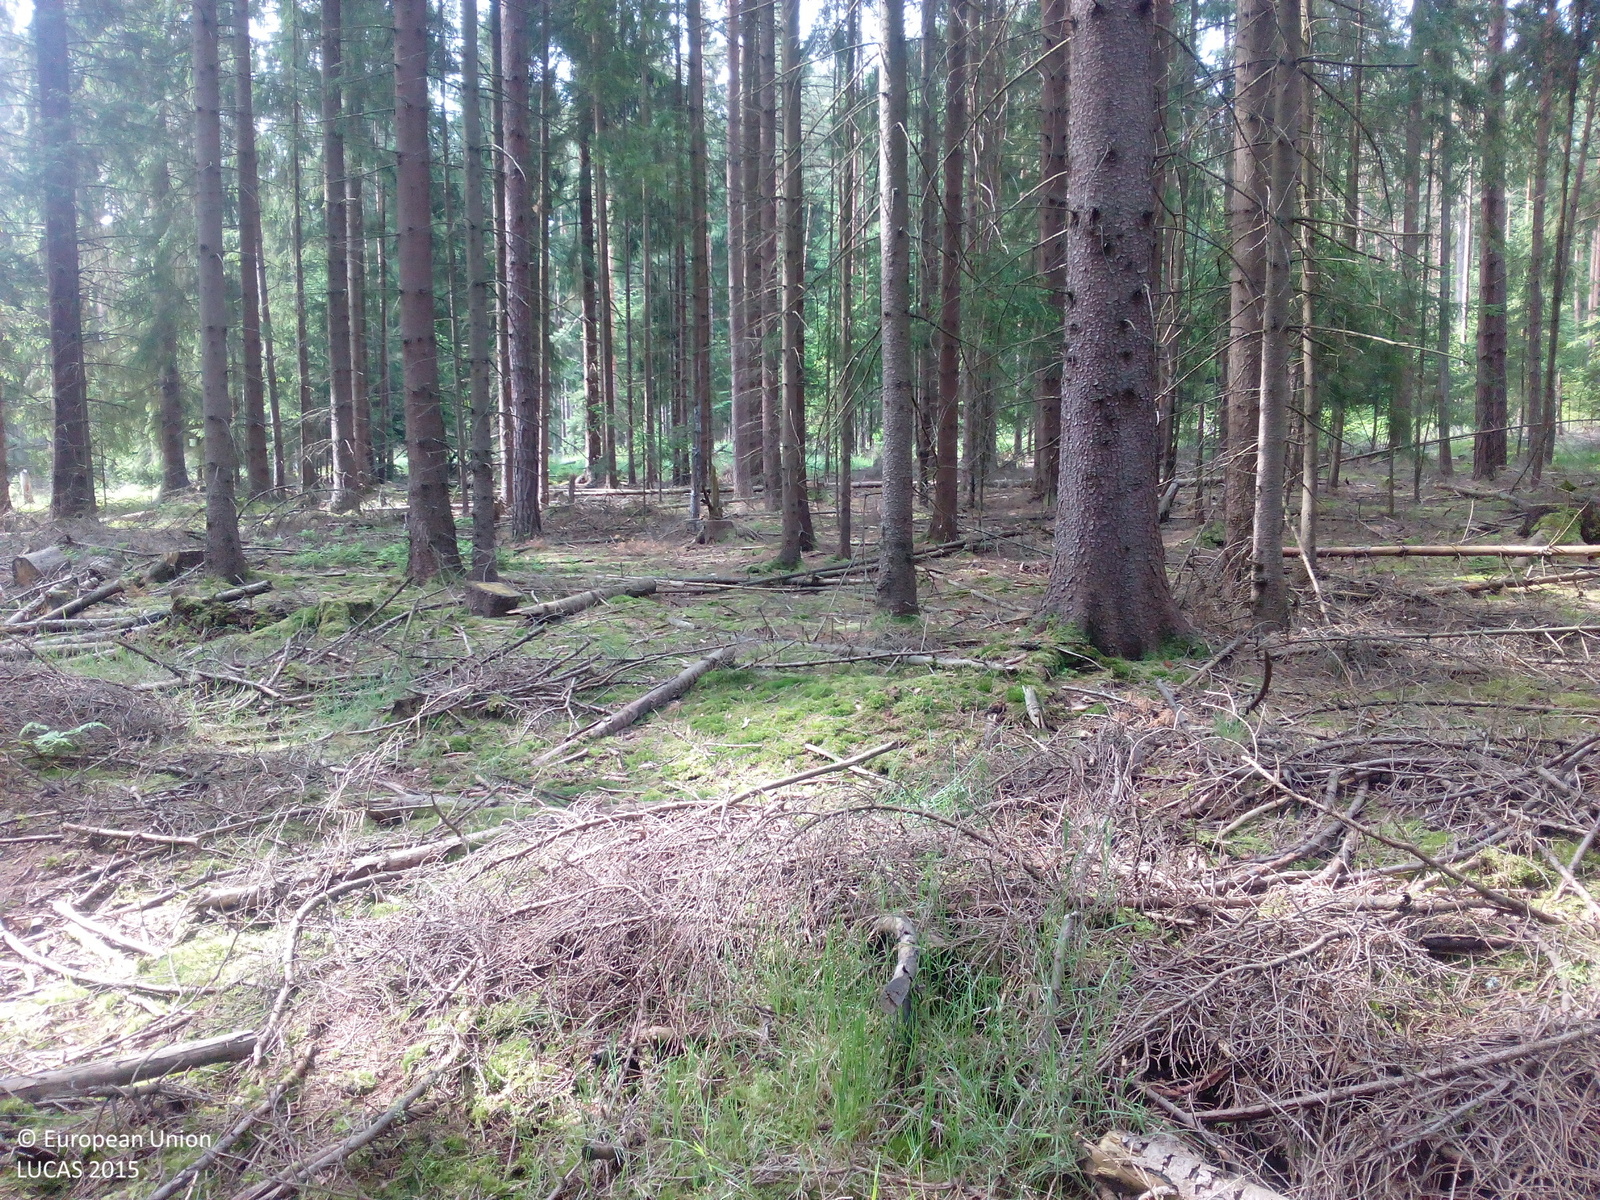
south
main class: Woodland
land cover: Spruce dominated coniferous woodland
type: hemiboreal forest and nemoral coniferous forest and mixed broadleaved-coniferous forest
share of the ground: 50 - 75 %
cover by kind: coniferous forest trees 65 %, herbaceous plants 20 %, shrubs 10 %
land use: Forestry
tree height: > 5 m
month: June
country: DE
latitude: 50.0721
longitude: 12.2491
